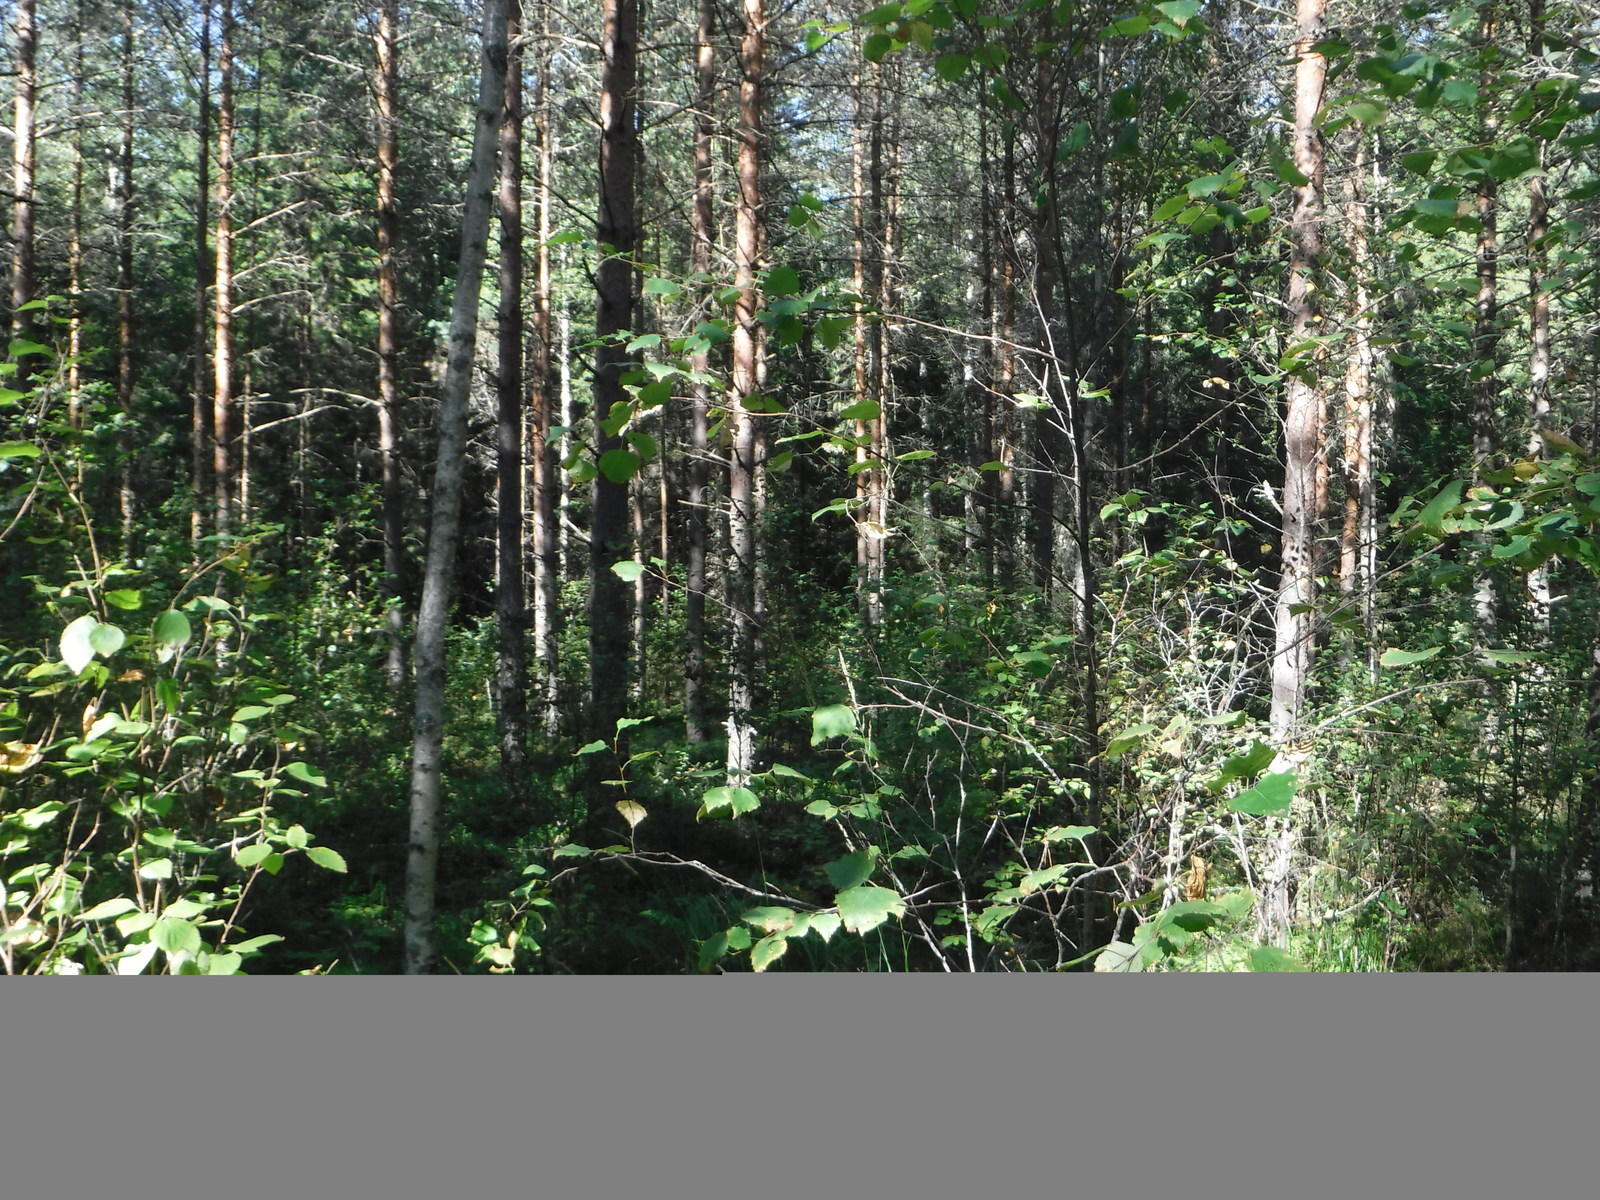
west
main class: Woodland
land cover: Pine dominated mixed woodland
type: boreal forest
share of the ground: 50 - 75 %
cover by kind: coniferous forest trees 40 %, broadleaved forest trees 30 %, herbaceous plants 25 %, shrubs 5 %
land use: Forestry
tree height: > 5 m
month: August
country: FI
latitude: 61.1984
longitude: 22.8539
